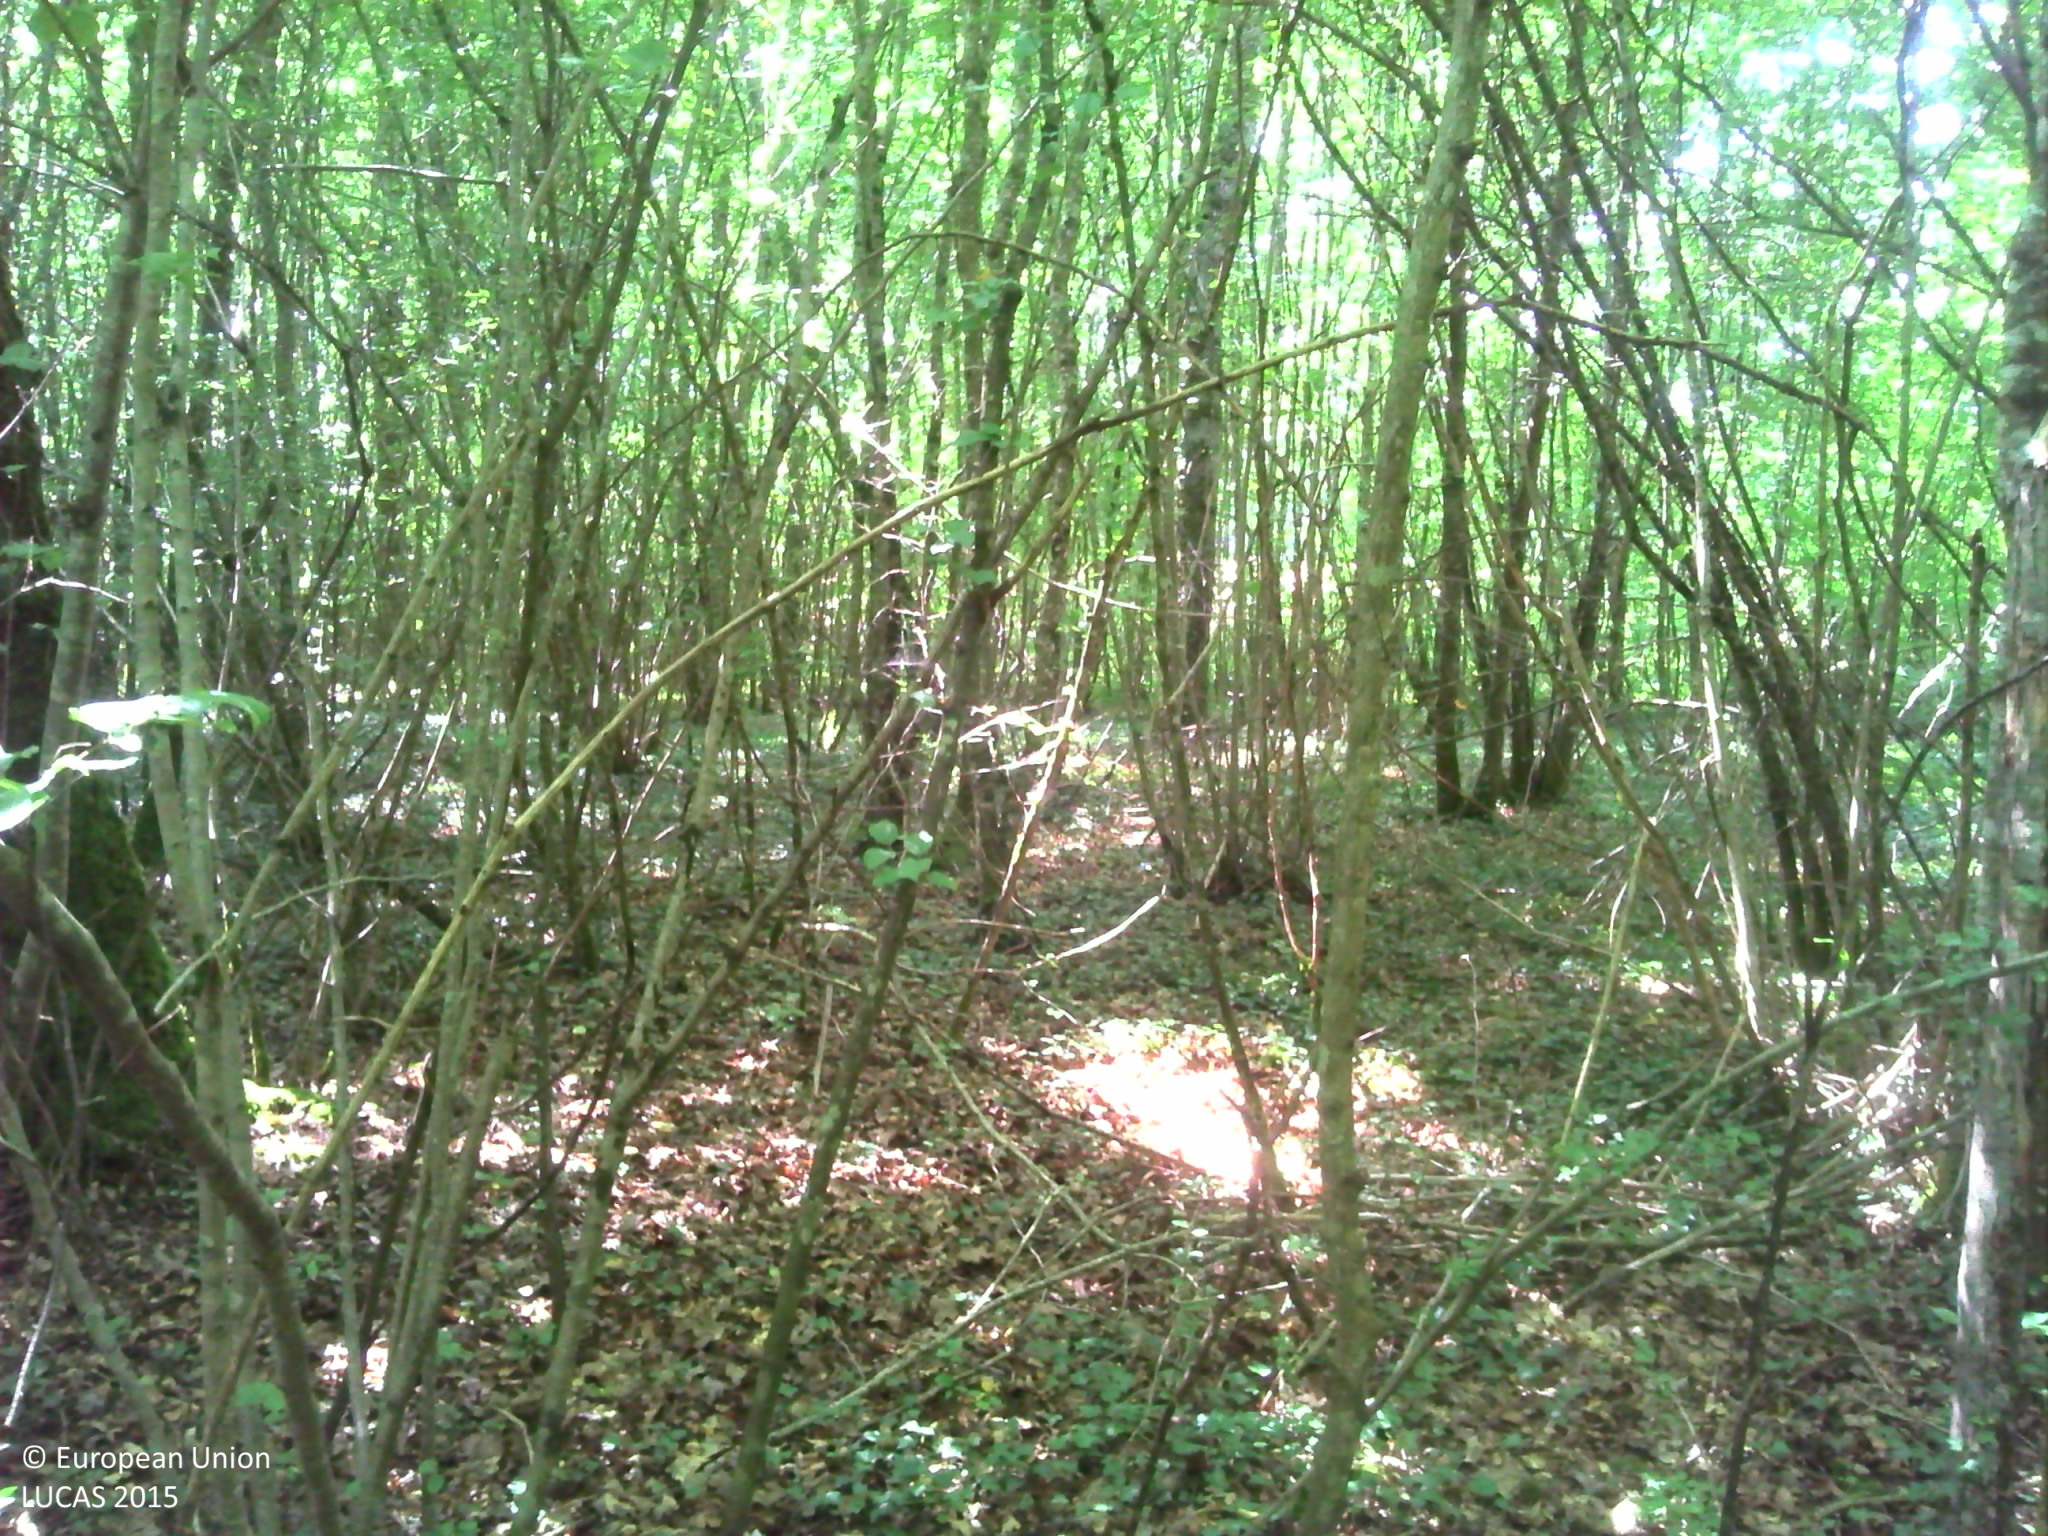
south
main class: Woodland
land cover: Broadleaved woodland
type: mesophytic deciduous forest
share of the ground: > 75 %
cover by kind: broadleaved forest trees 90 %, herbaceous plants 5 %, lichens and mosses 5 %
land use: Forestry
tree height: > 5 m
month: July
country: FR
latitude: 47.6385
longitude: 3.5673
